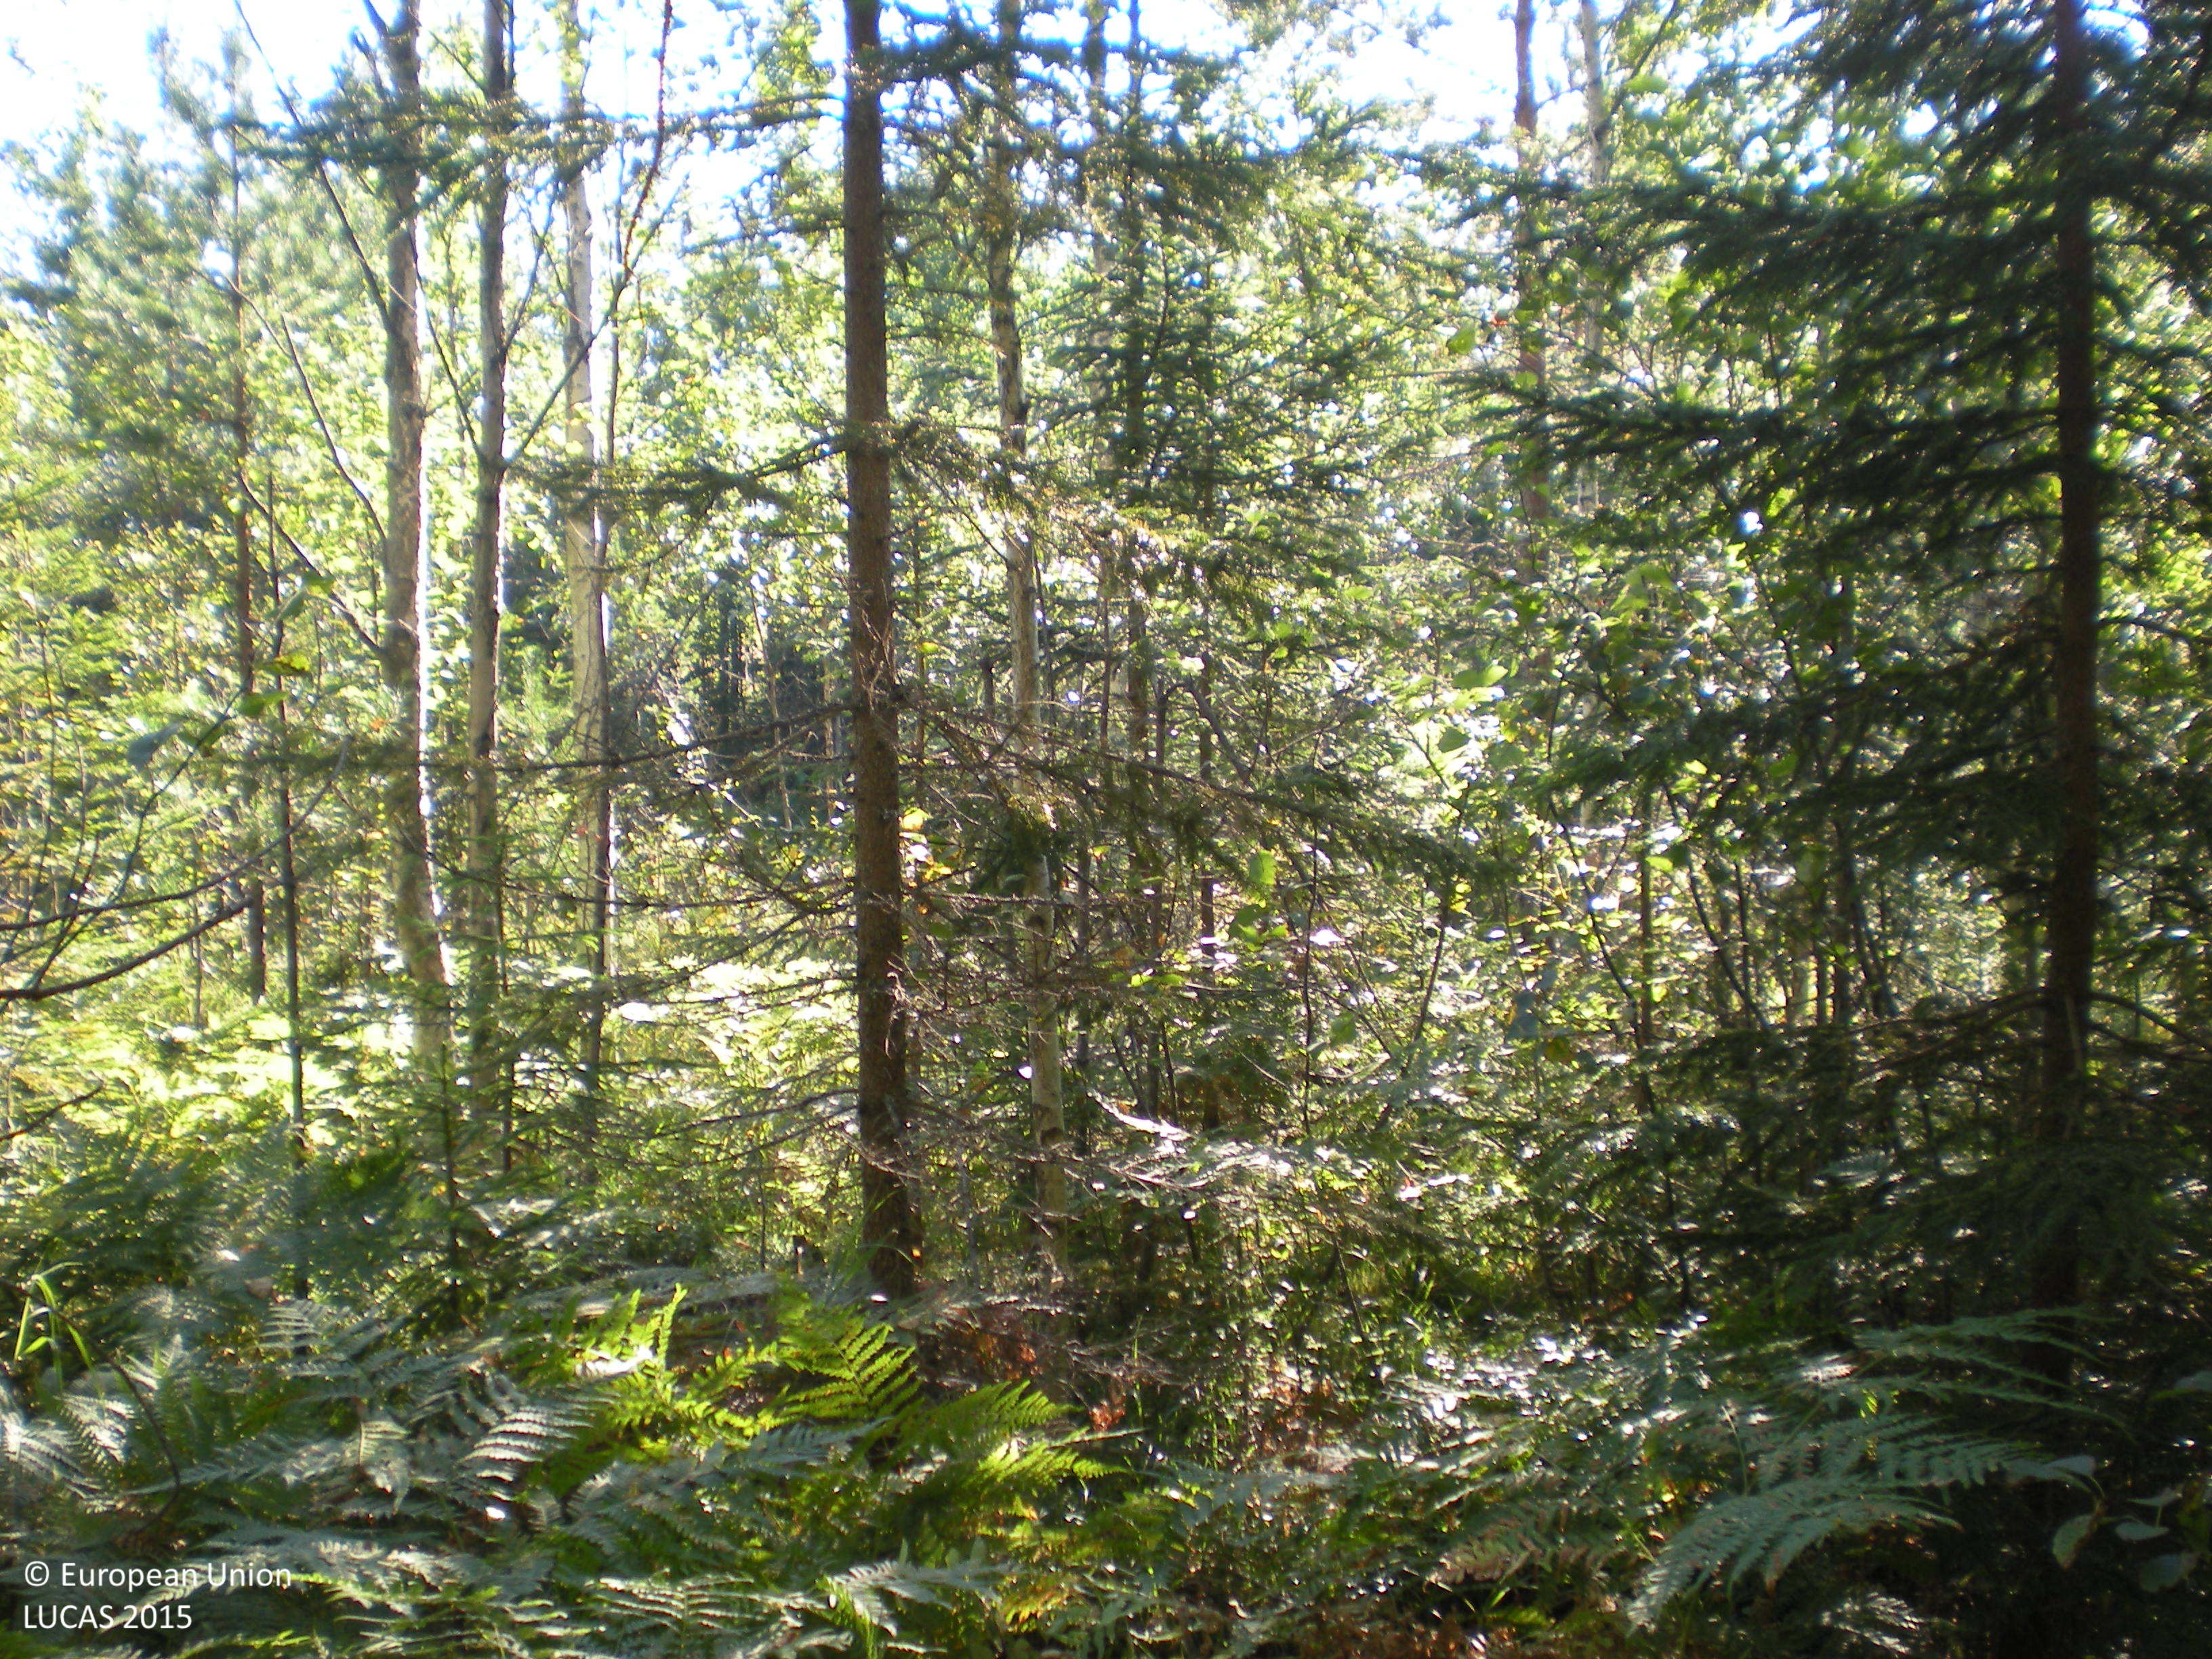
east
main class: Woodland
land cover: Spruce dominated mixed woodland
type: boreal forest
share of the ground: > 75 %
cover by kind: coniferous forest trees 55 %, broadleaved forest trees 25 %, herbaceous plants 10 %, shrubs 5 %, lichens and mosses 5 %
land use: Forestry
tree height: > 5 m
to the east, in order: Spruce dominated mixed woodland; Pine dominated mixed woodland; Grassland with sparse tree/shrub cover; Spruce dominated mixed woodland; Grassland with sparse tree/shrub cover; Broadleaved woodland; Pine dominated mixed woodland; Broadleaved woodland; Pine dominated mixed woodland
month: August
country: SE
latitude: 60.6293
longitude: 17.2094
